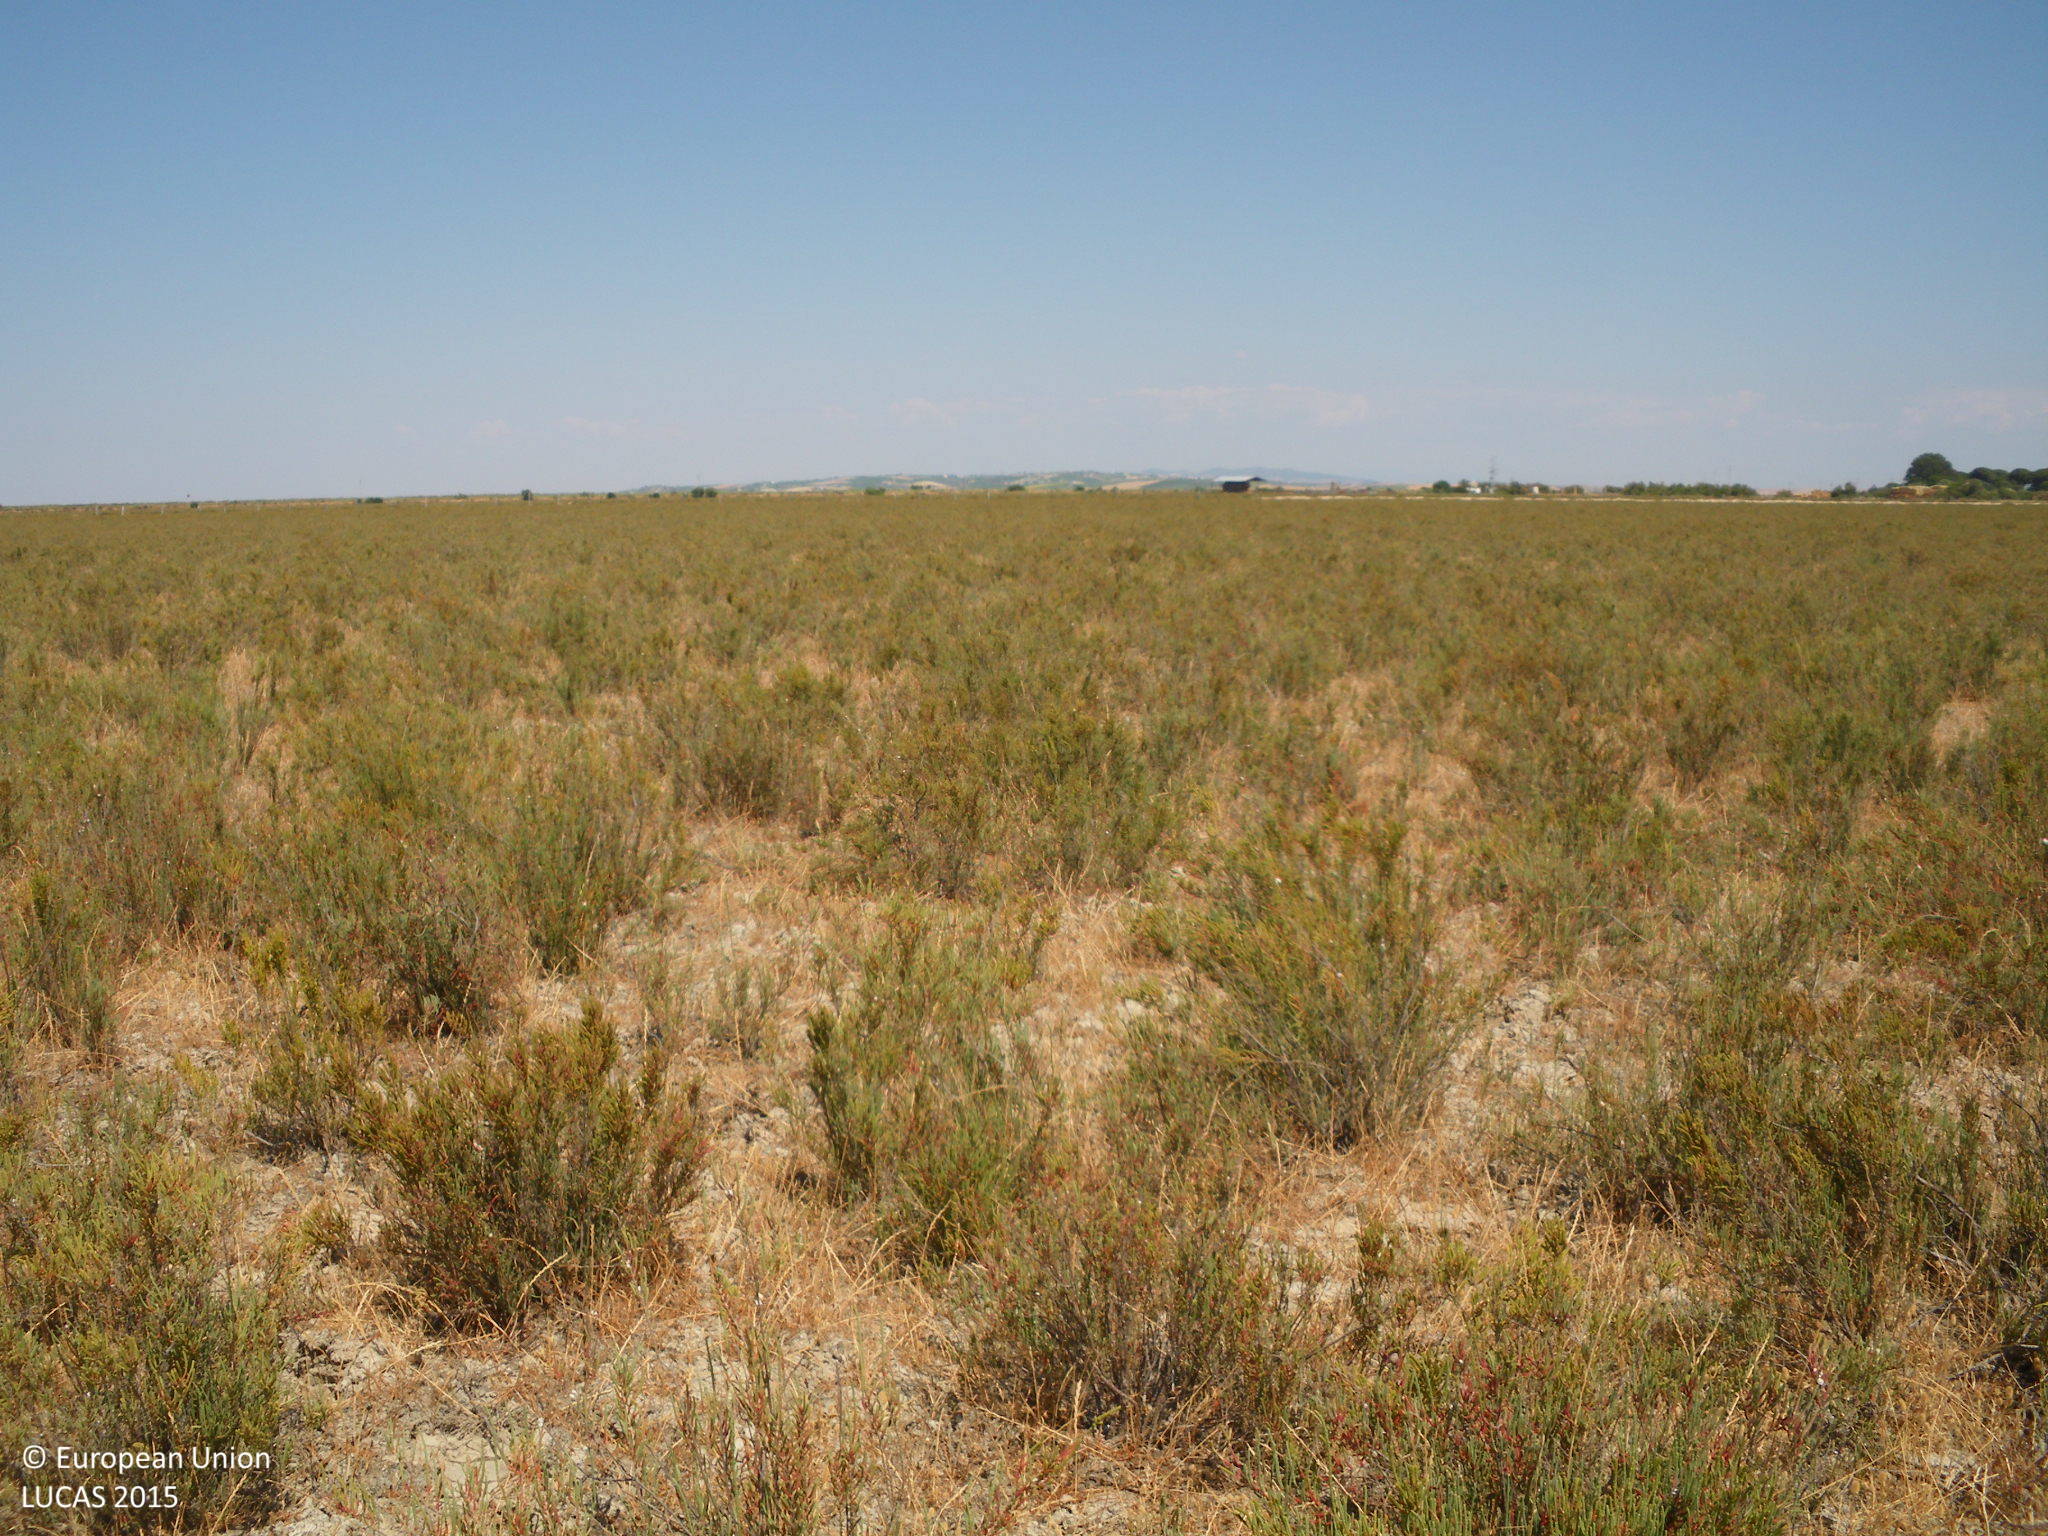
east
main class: Shrubland
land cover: Shrubland without tree cover
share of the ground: 50 - 75 %
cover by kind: shrubs 50 %, herbaceous plants 35 %, unconsolidated bare surface 15 %
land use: Agriculture (excluding fallow land and kitchen gardens)
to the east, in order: Shrubland without tree cover; Tracks; Shrubland without tree cover; Tracks; Shrubland without tree cover; Tracks; Shrubland without tree cover
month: May
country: ES
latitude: 36.8846
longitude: -6.2993
